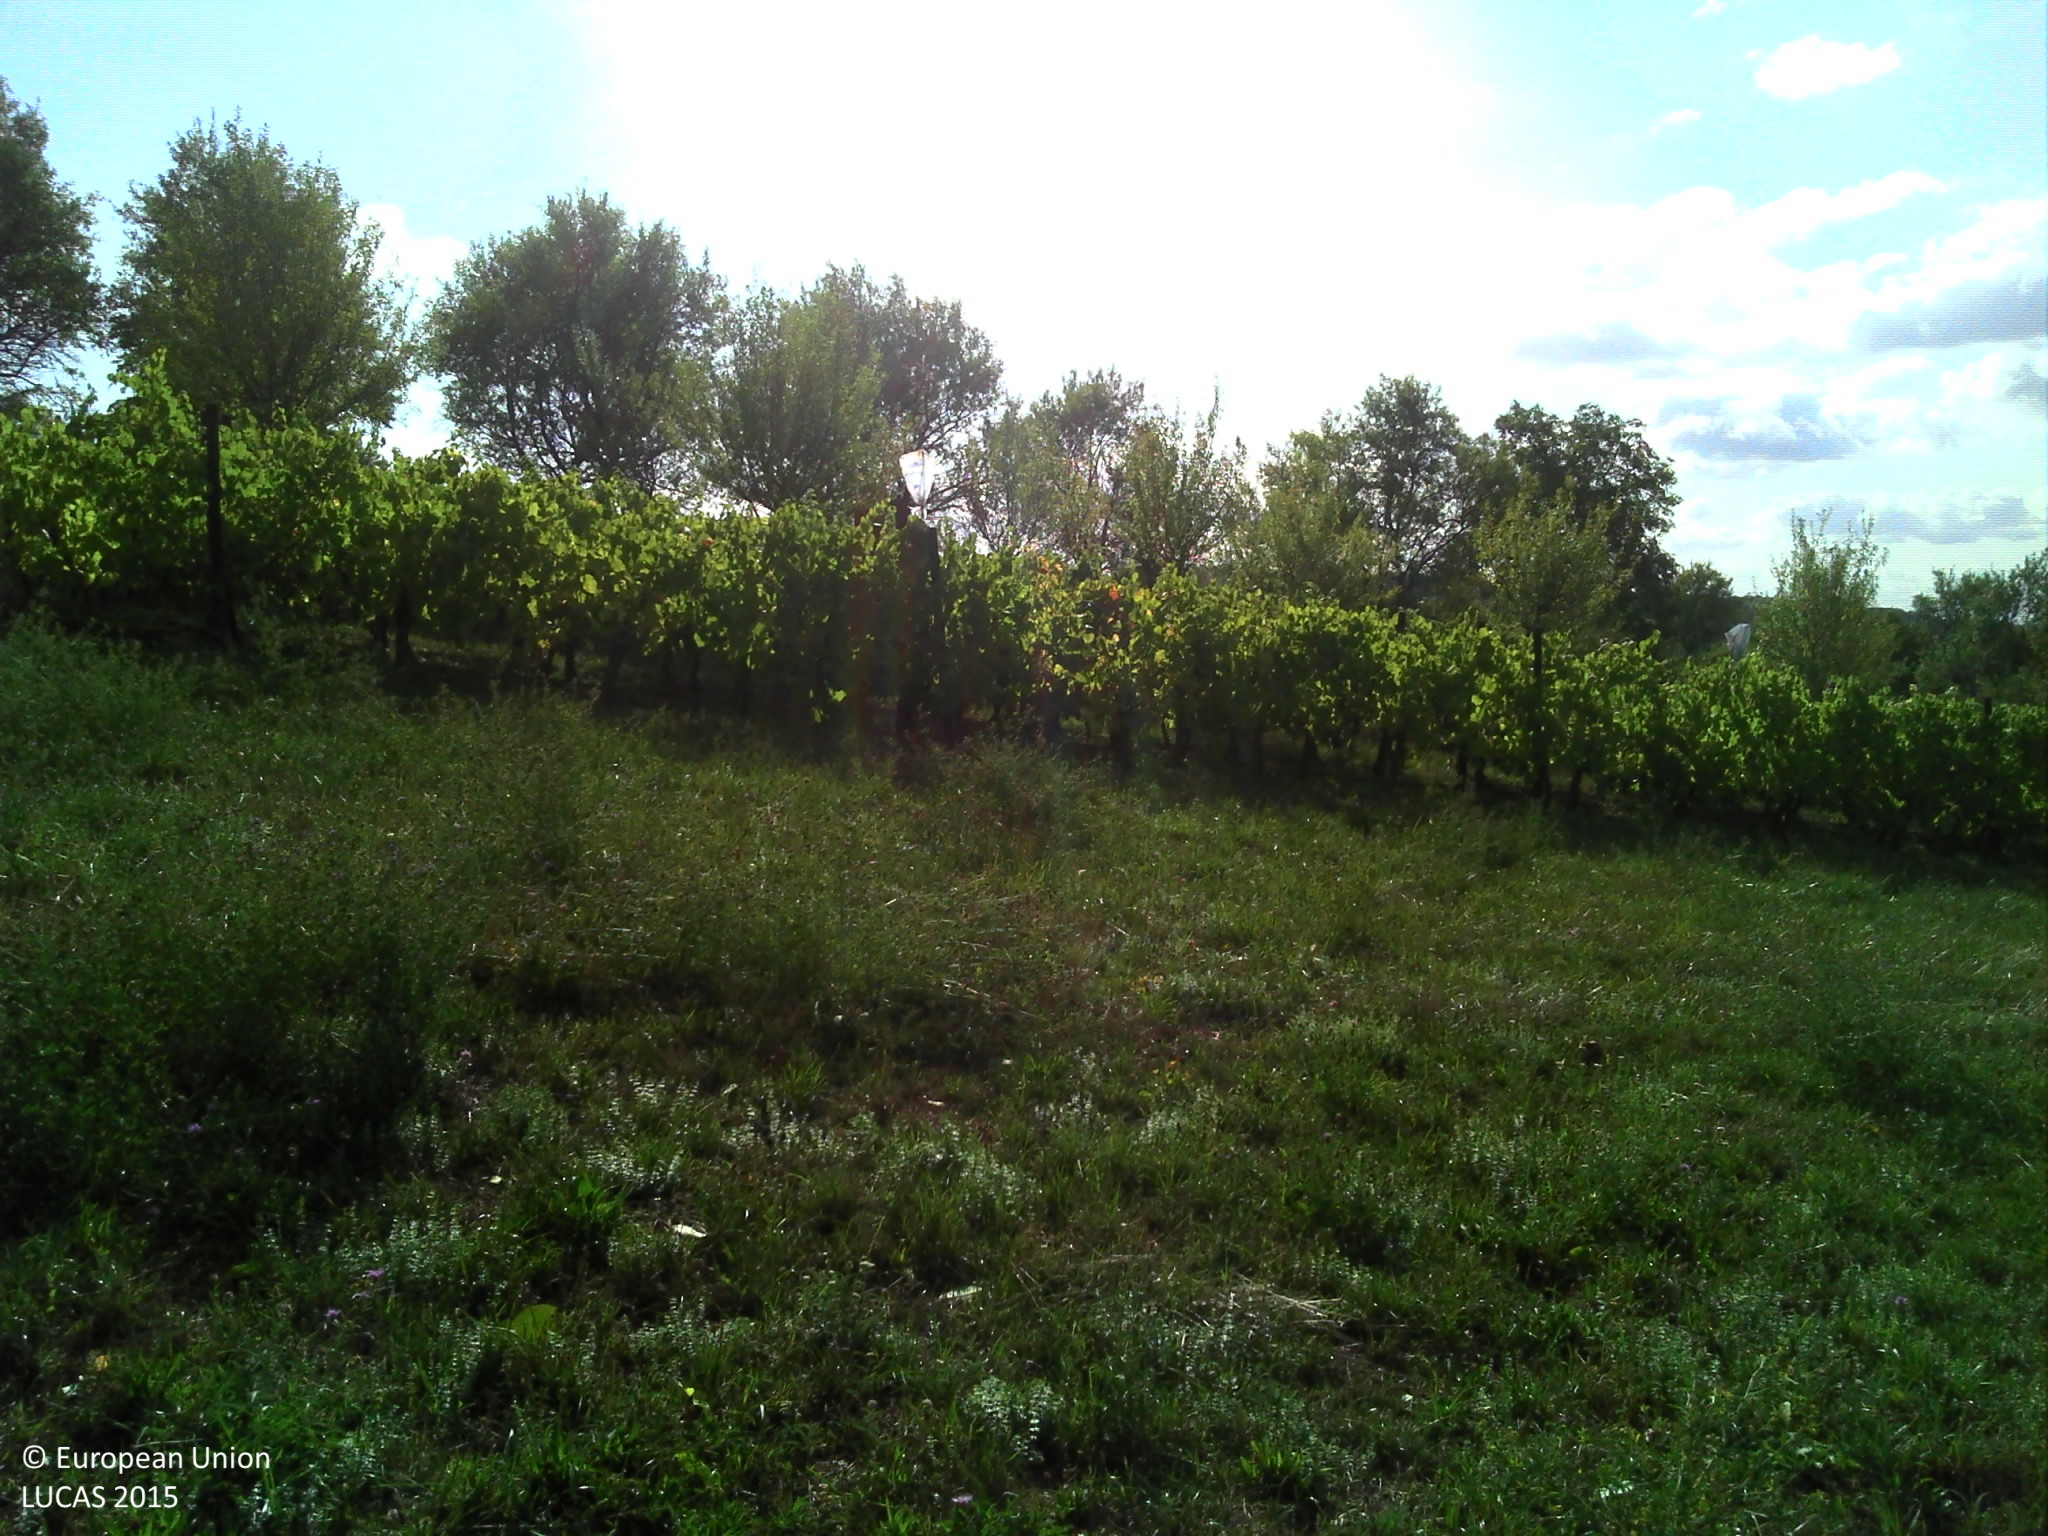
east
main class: Grassland
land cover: Grassland without tree/shrub cover
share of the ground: > 75 %
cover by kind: herbaceous plants 100 %
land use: Agriculture (excluding fallow land and kitchen gardens)
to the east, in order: Grassland without tree/shrub cover; Vineyards; Fences; Other fruit trees and berries; Fences; Grassland without tree/shrub cover; Vineyards; Fences; Broadleaved woodland; Grassland with sparse tree/shrub cover; Fences; Apple fruit; Fences; Broadleaved woodland; Fences; Broadleaved woodland; Fences; Broadleaved woodland
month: August
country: FR
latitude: 48.8092
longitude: 7.5905
